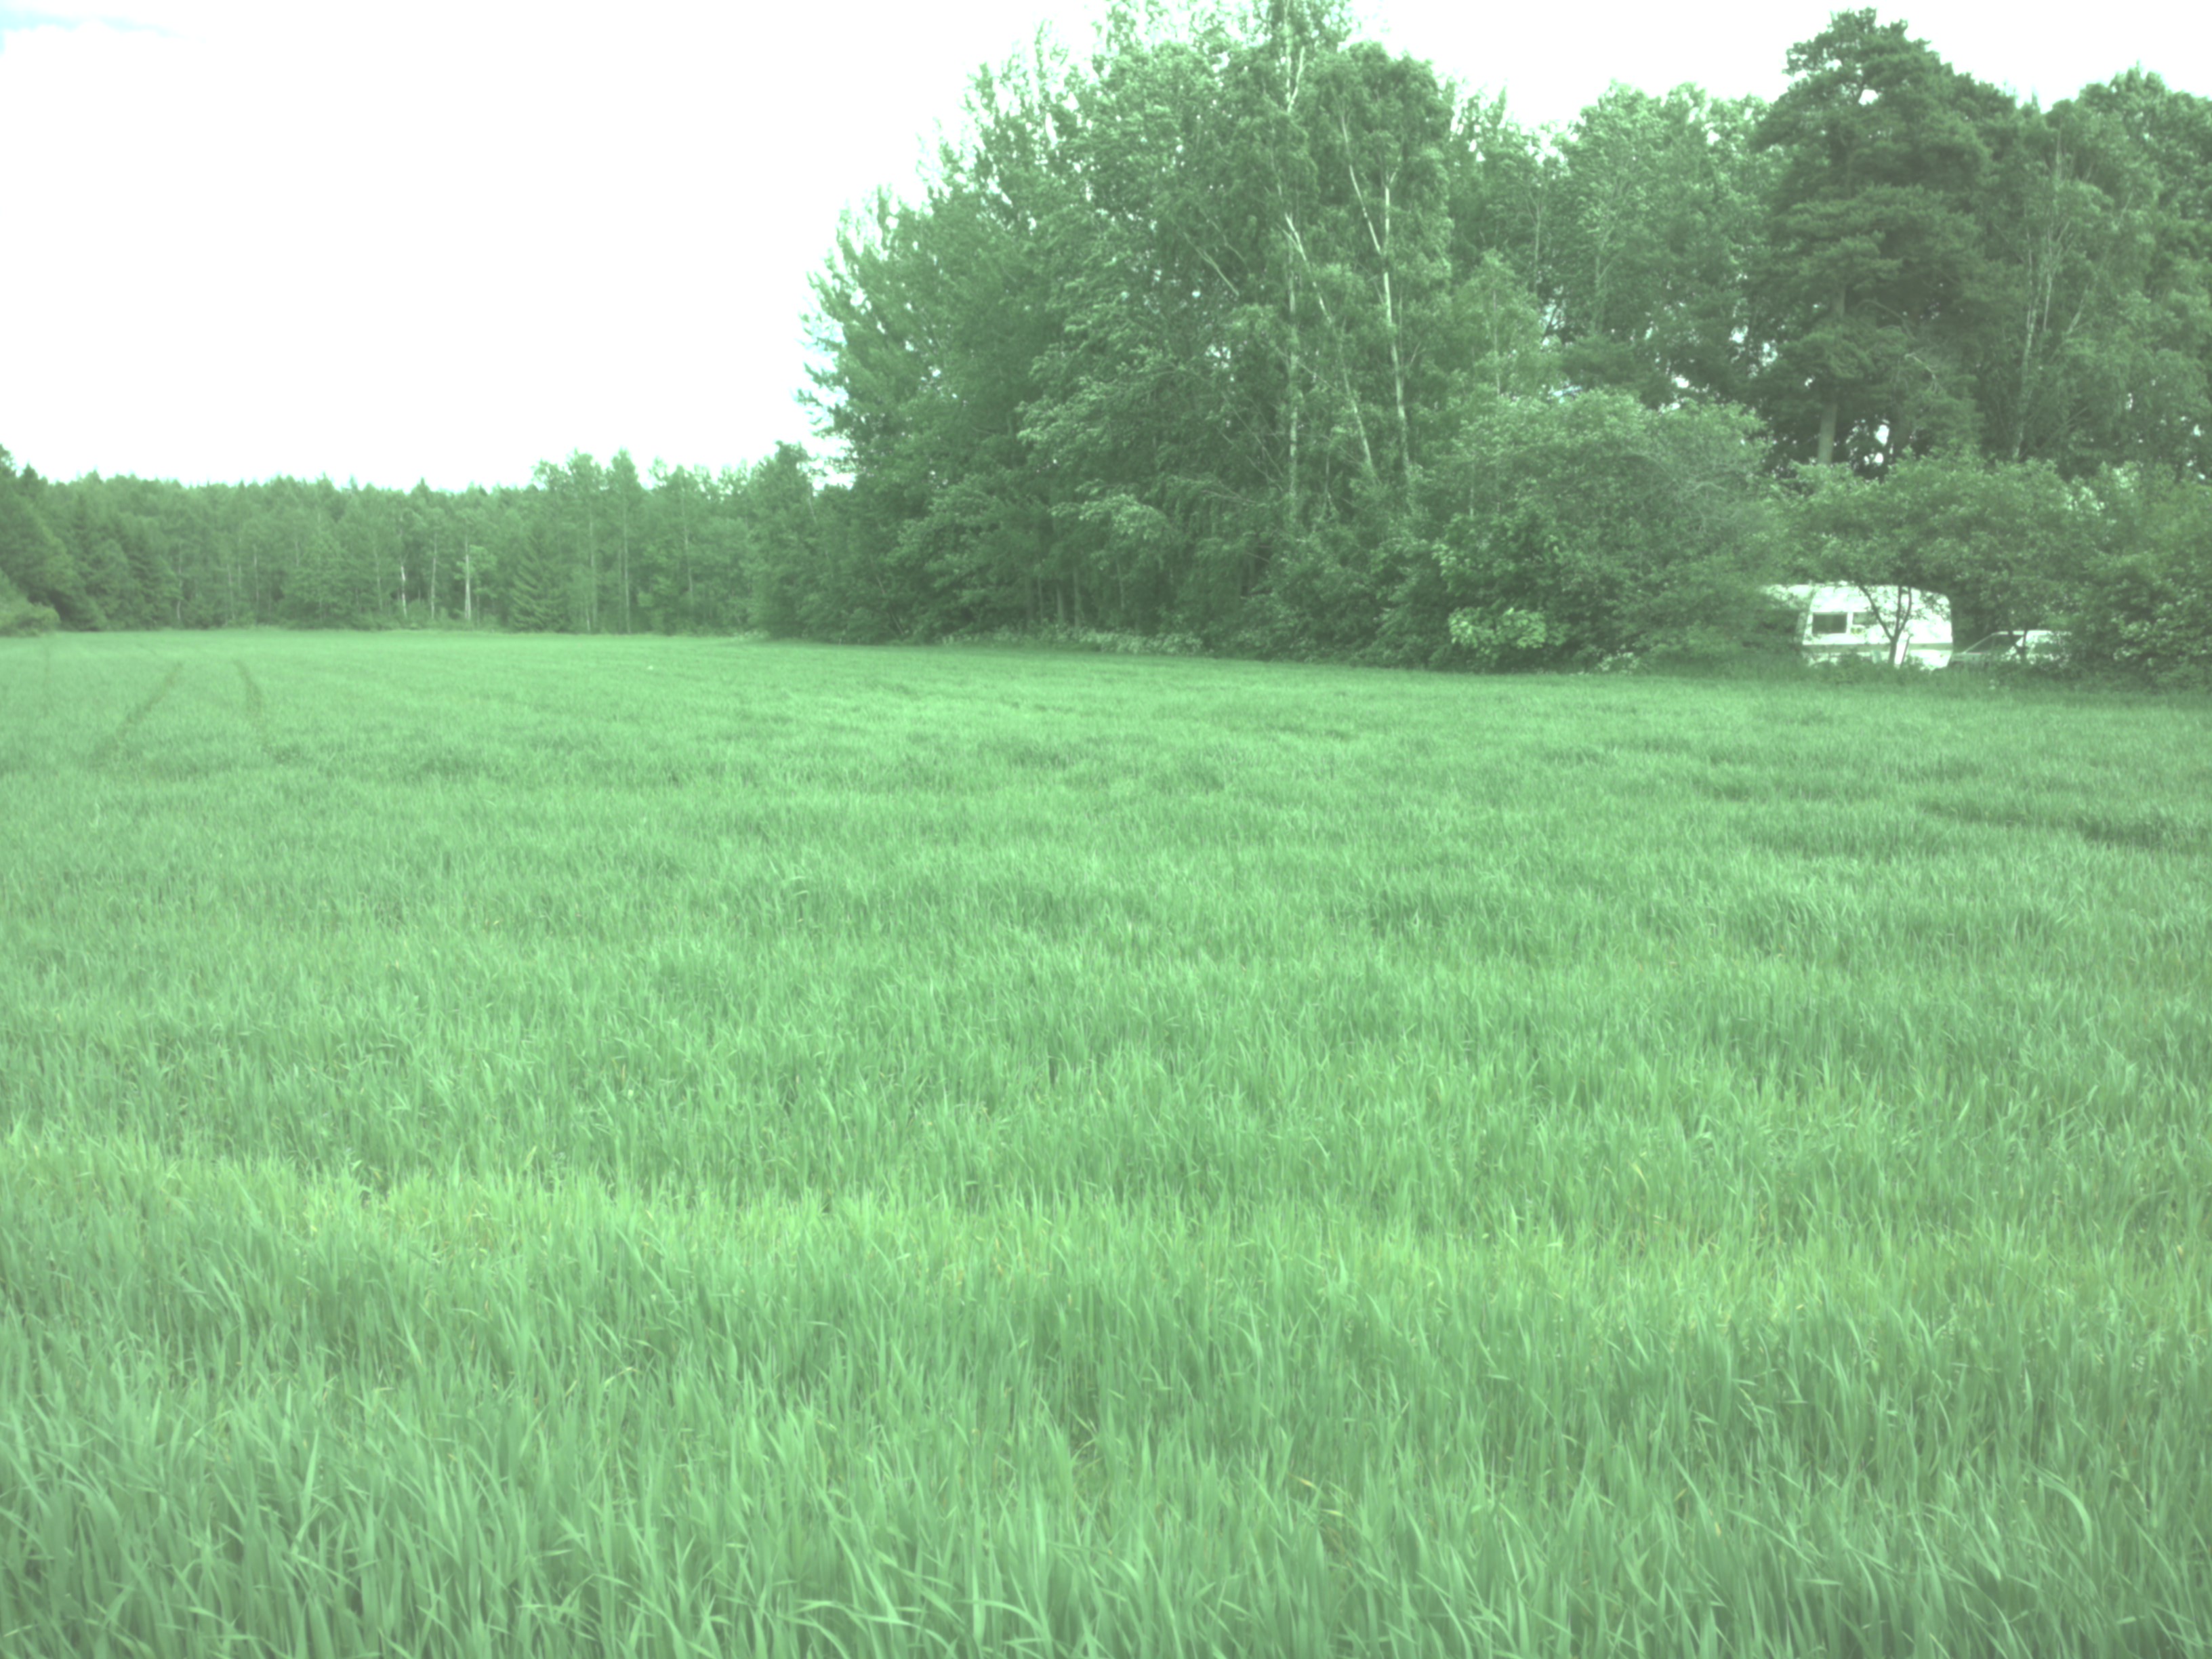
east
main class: Cropland
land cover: Oats
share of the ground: > 75 %
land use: Agriculture (excluding fallow land and kitchen gardens)
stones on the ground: < 10 %
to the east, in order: Oats; Ditches and canals; Broadleaved woodland; Ditches and canals; Oats; Ditches and canals; Broadleaved woodland
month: June
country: SE
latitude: 59.4172
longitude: 17.5555
